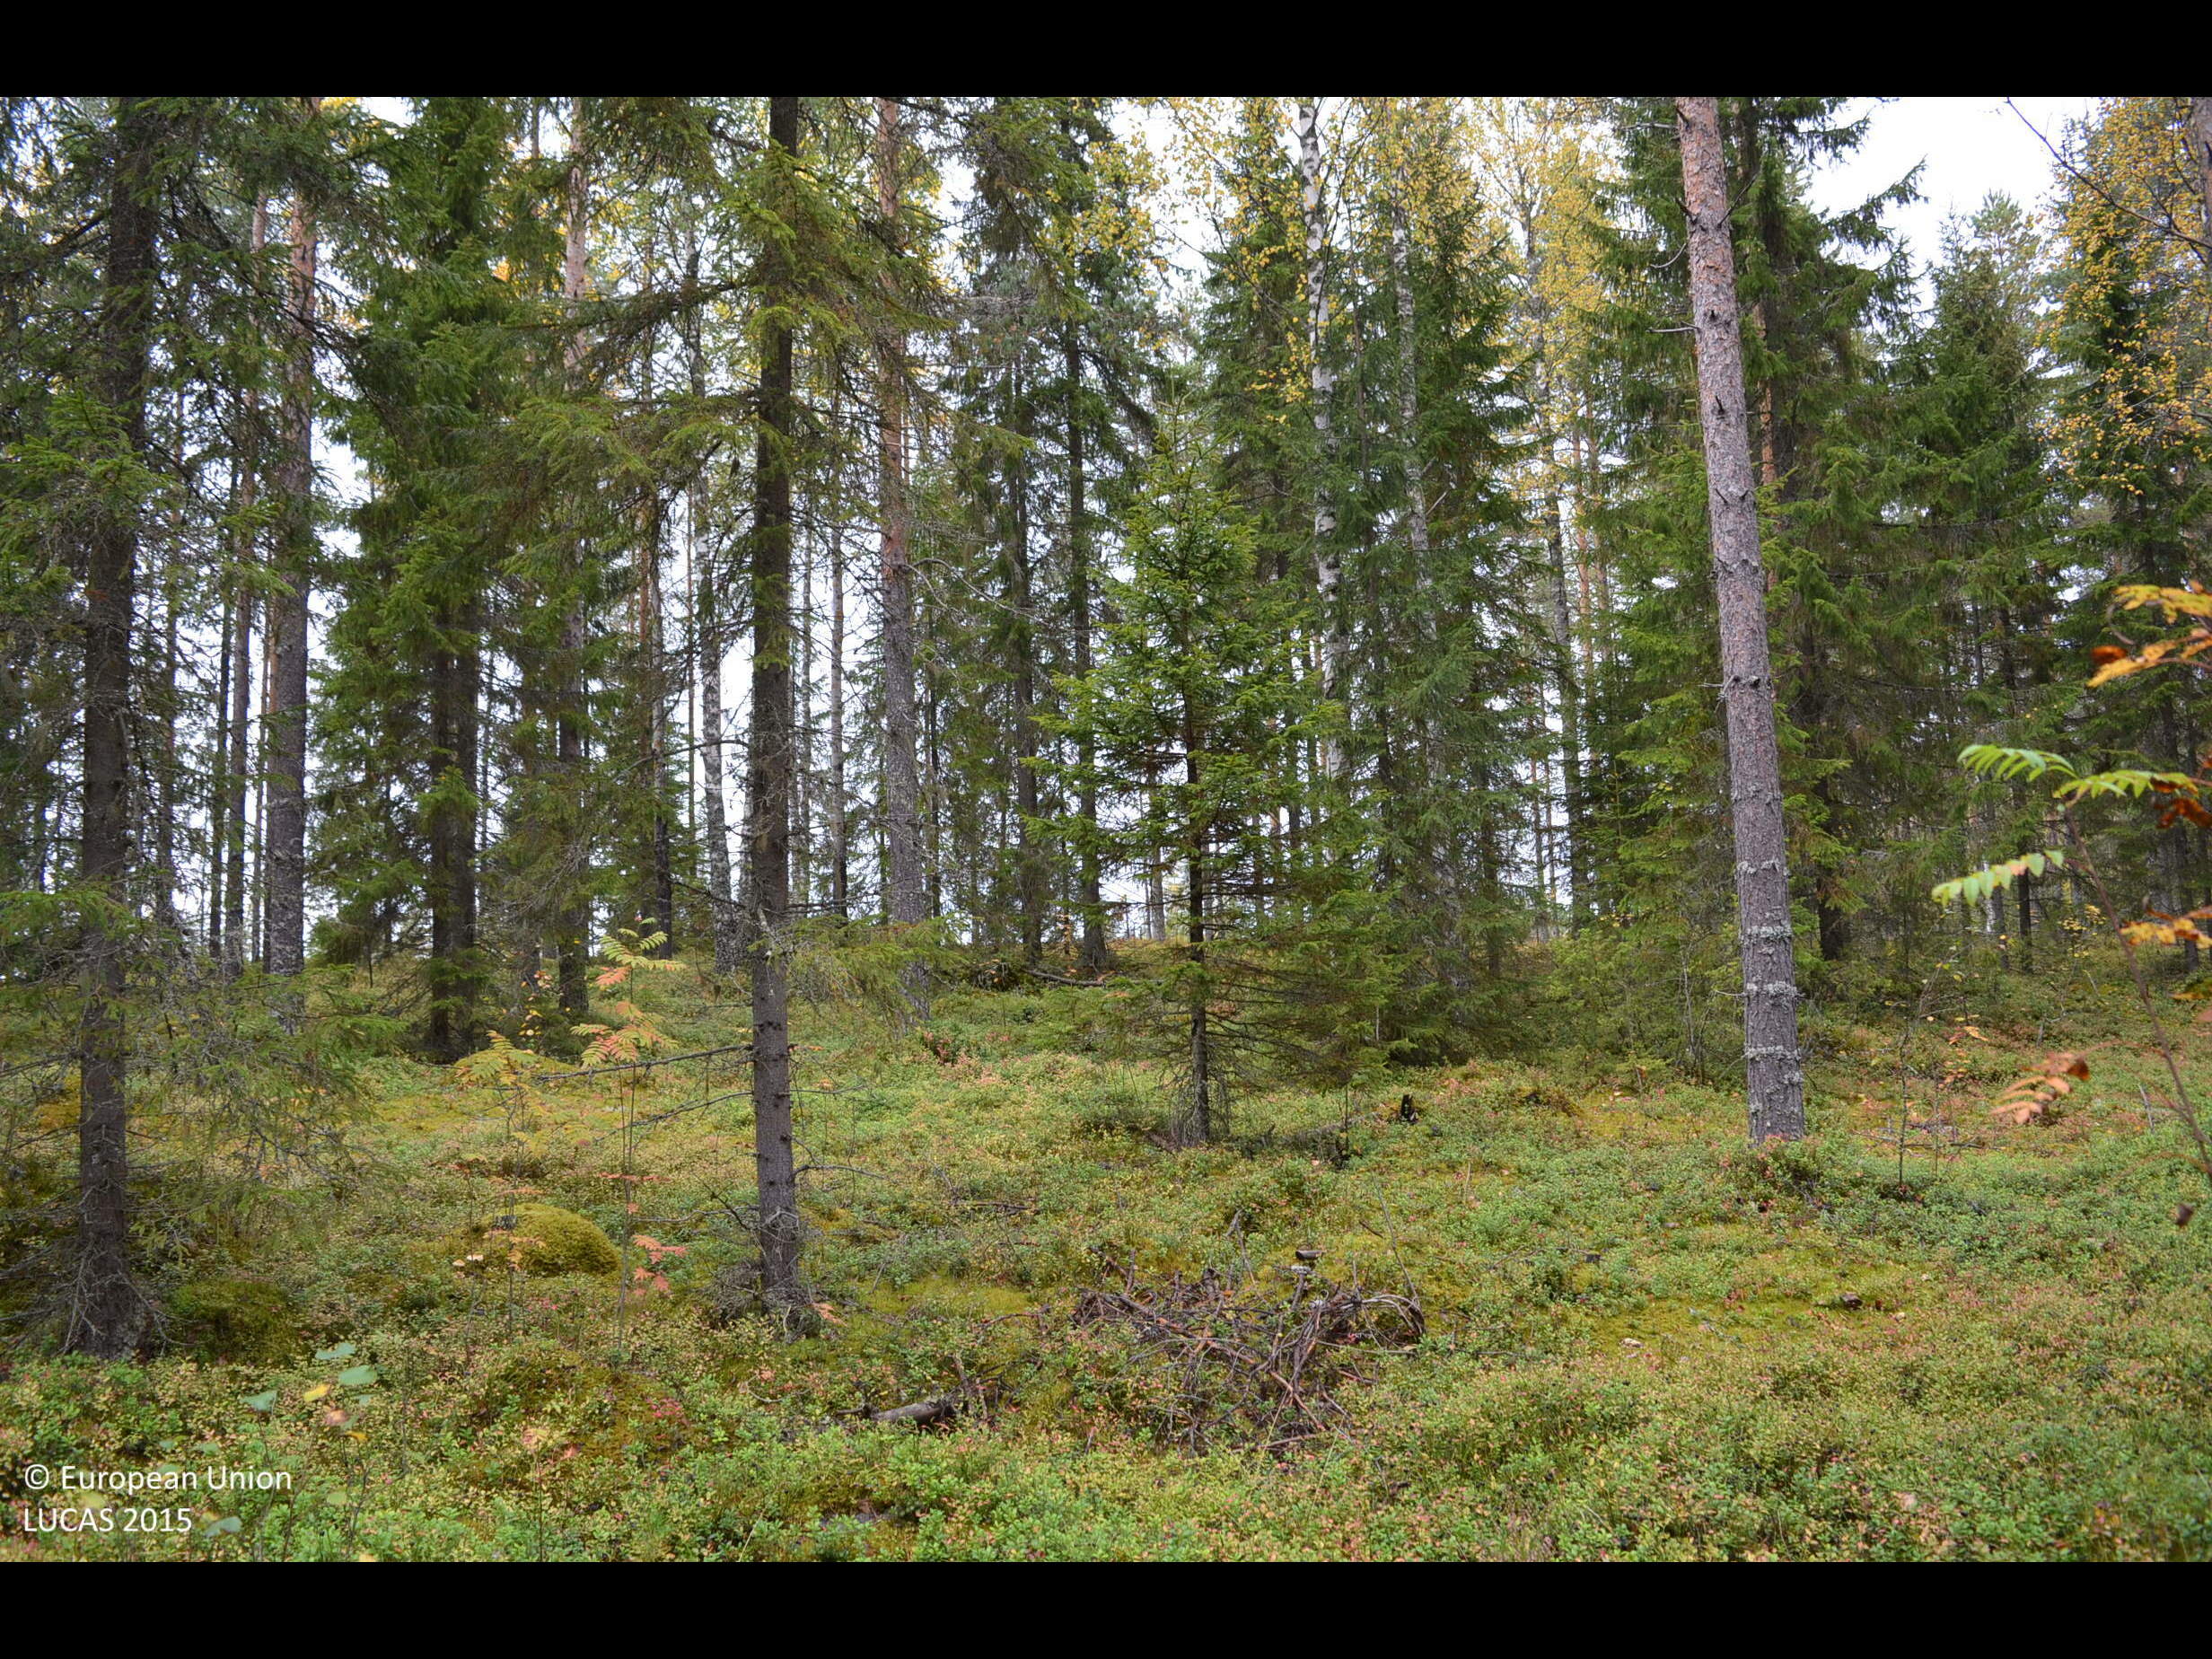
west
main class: Woodland
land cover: Other mixed woodland
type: boreal forest
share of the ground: 50 - 75 %
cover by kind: coniferous forest trees 50 %, broadleaved forest trees 20 %, shrubs 20 %, lichens and mosses 10 %
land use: Forestry
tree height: > 5 m
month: September
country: FI
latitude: 62.5683
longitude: 23.7136
